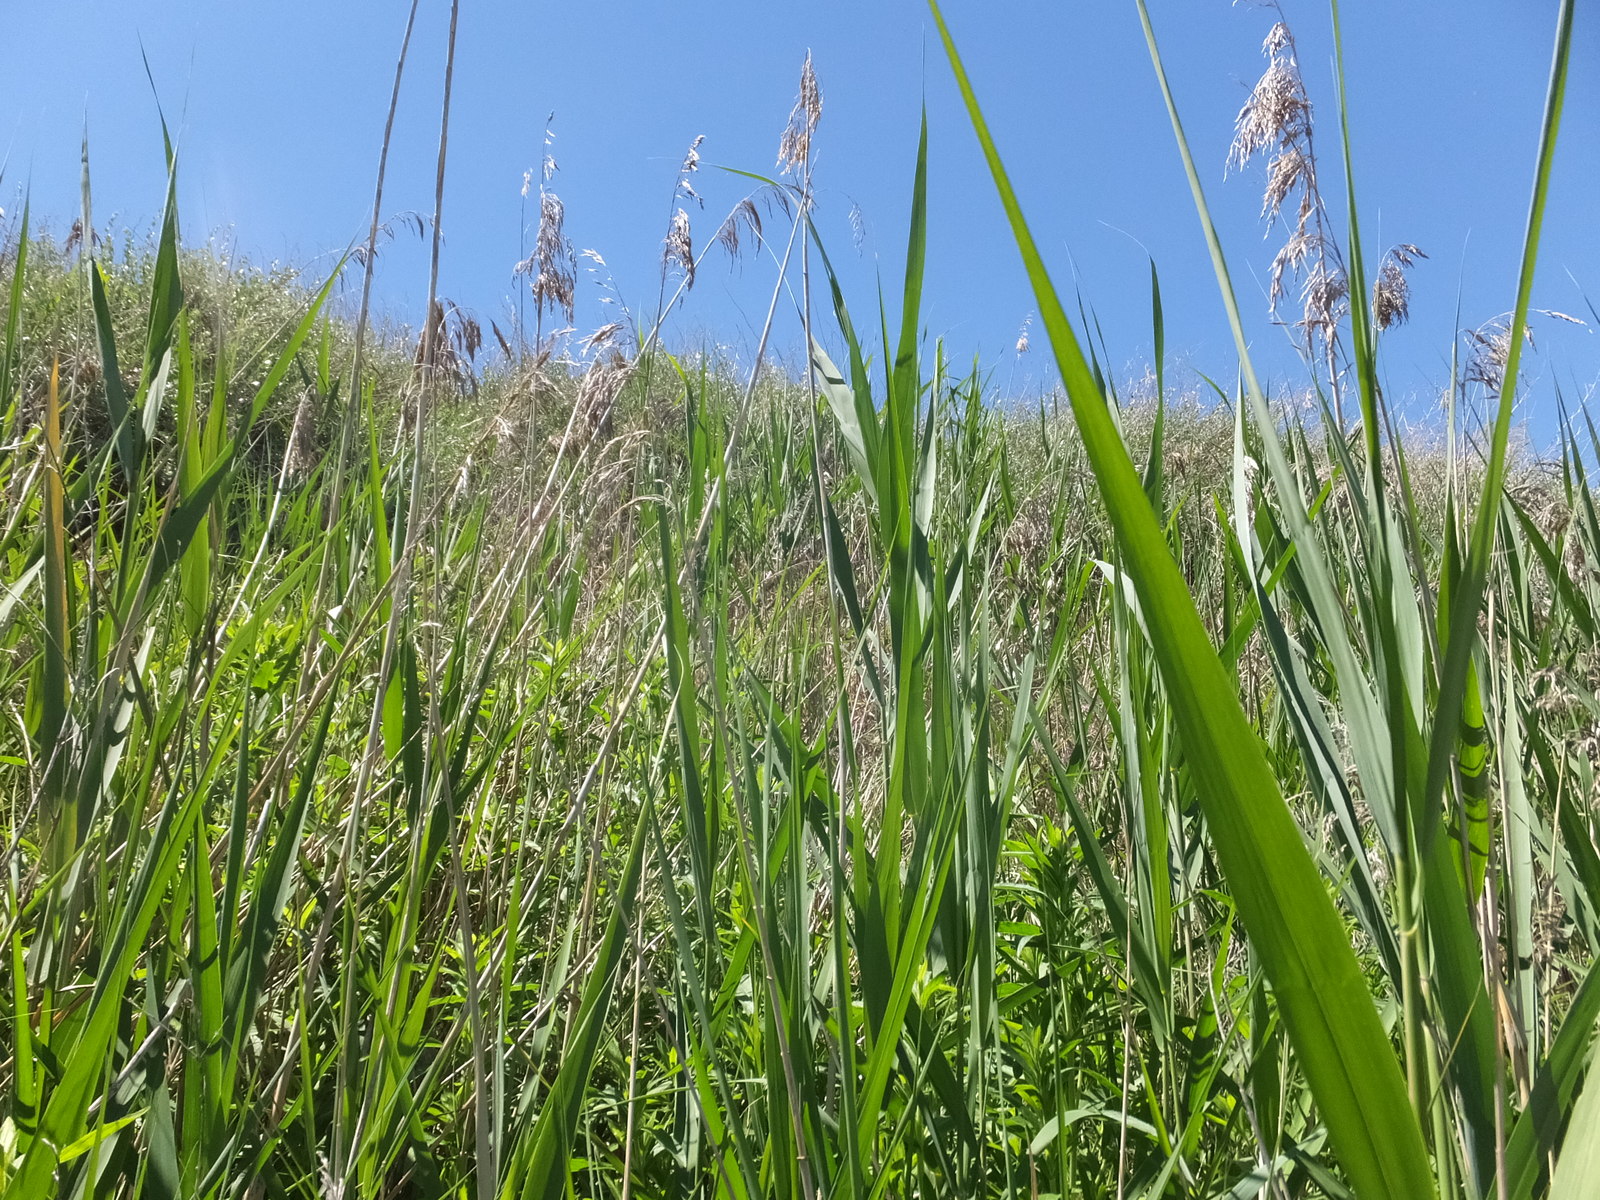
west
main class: Shrubland
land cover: Shrubland without tree cover
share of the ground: > 75 %
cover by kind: herbaceous plants 70 %, shrubs 30 %
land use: Semi-natural and natural areas not in use
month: May
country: ES
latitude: 41.7935
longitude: -0.1869
